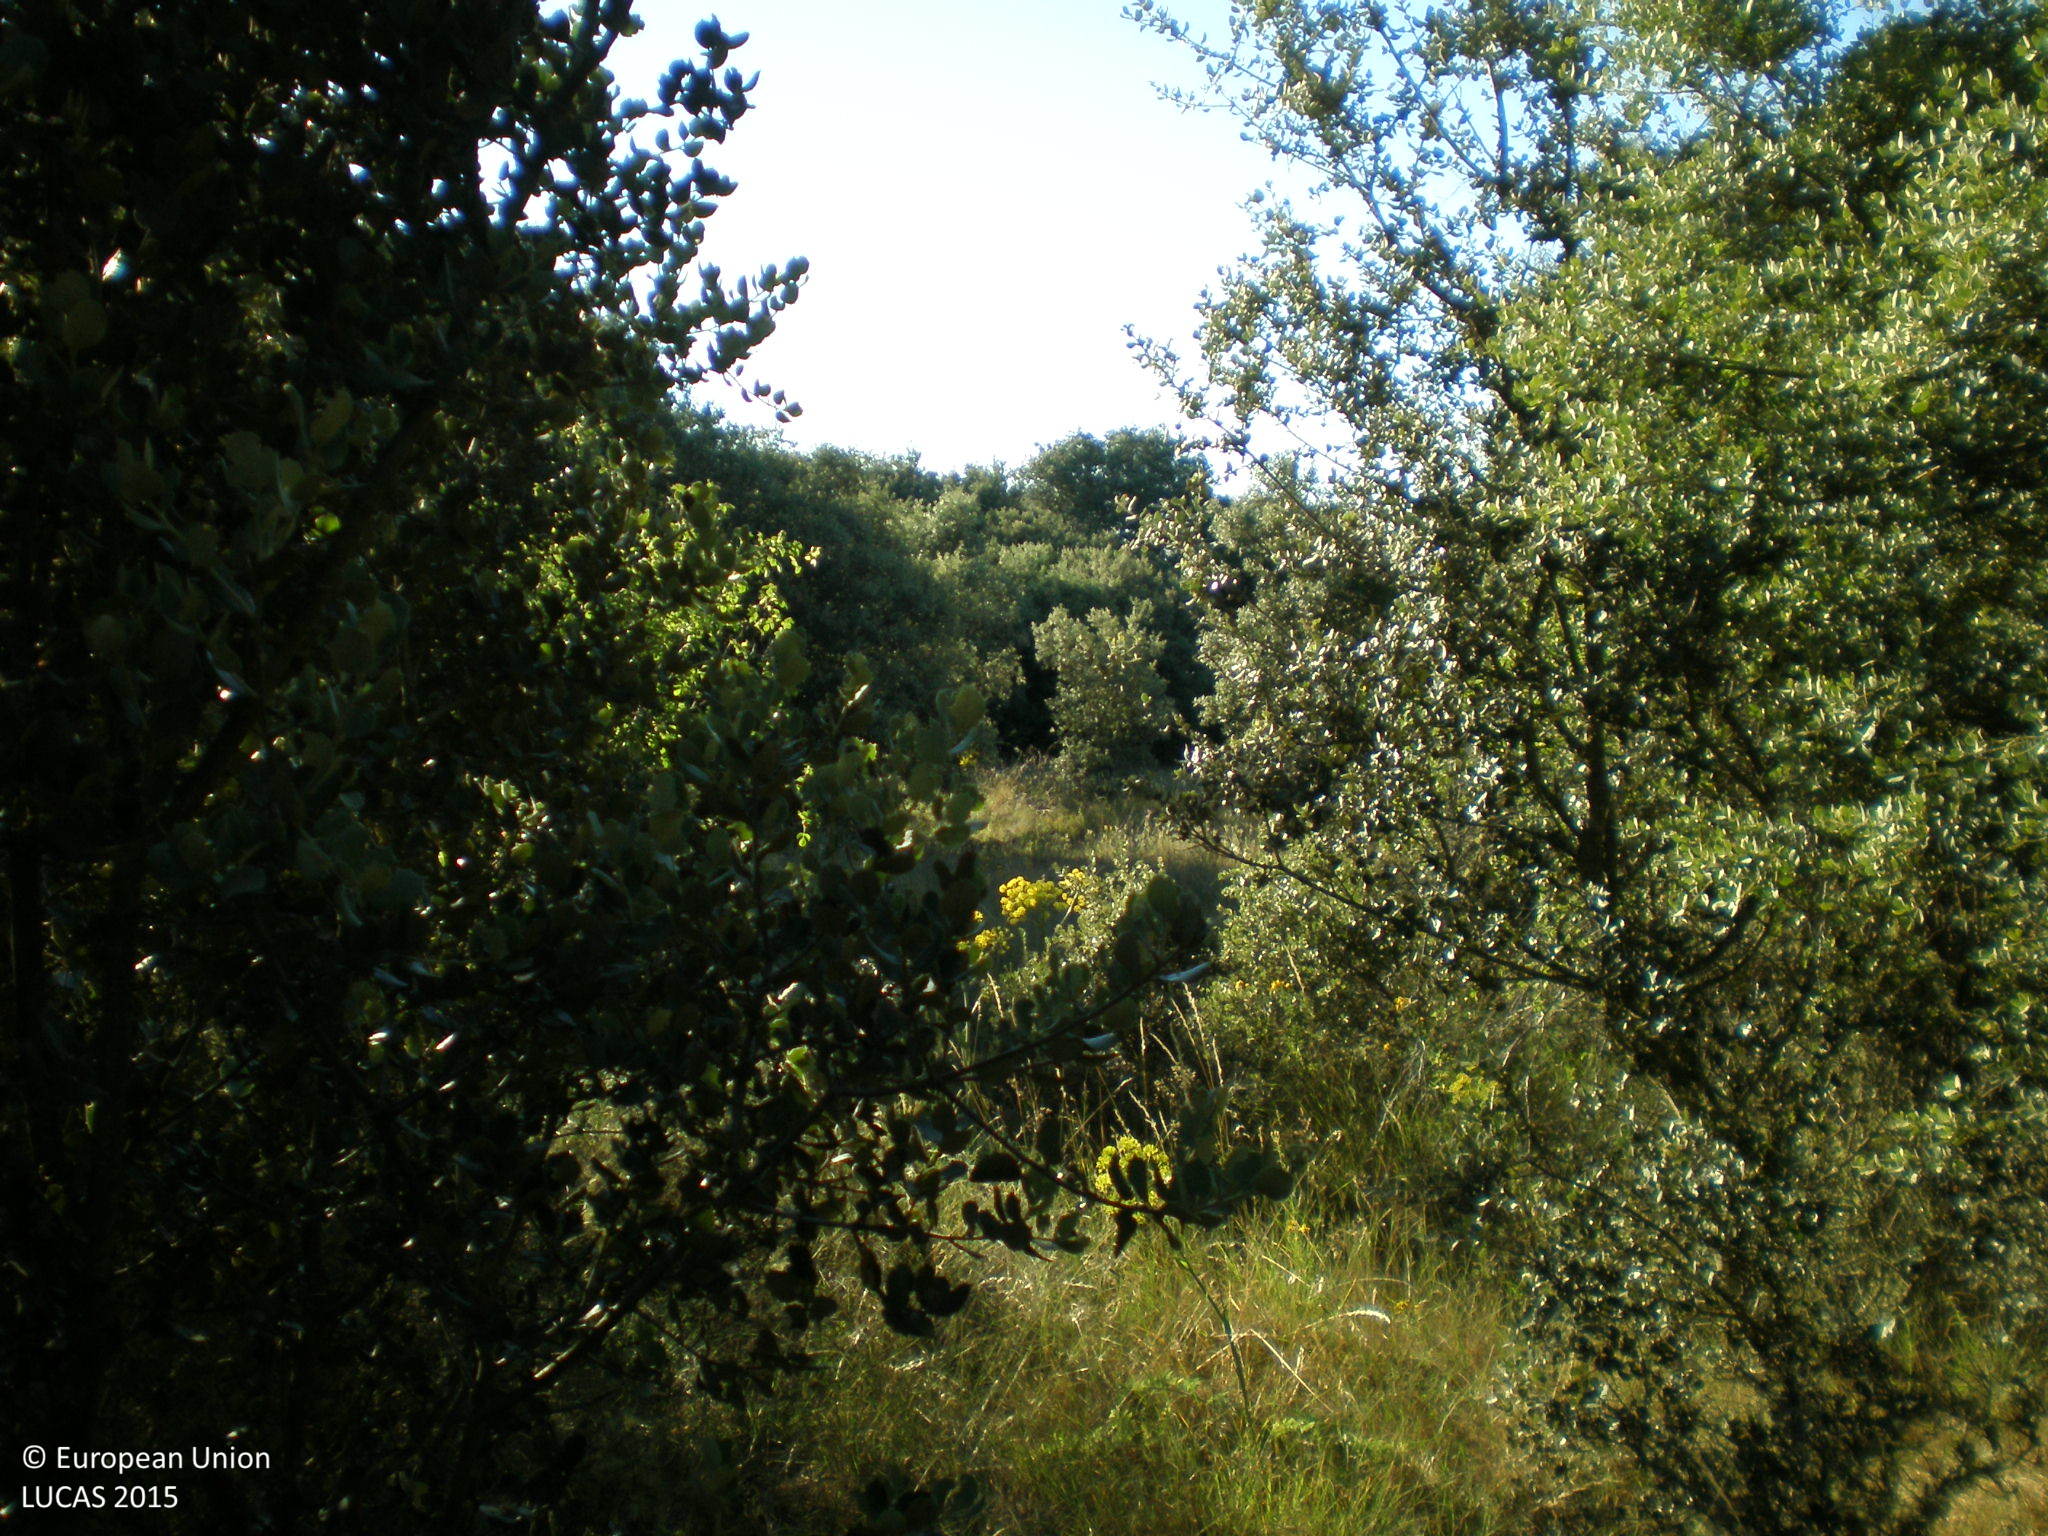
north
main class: Woodland
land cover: Broadleaved woodland
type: broadleaved evergreen forest
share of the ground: 25 - 50 %
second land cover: Grassland without tree/shrub cover
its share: 50 - 75 %
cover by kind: herbaceous plants 55 %, broadleaved forest trees 45 %
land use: Forestry
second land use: Agriculture (excluding fallow land and kitchen gardens)
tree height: > 5 m
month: June
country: ES
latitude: 40.7419
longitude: -5.6947
